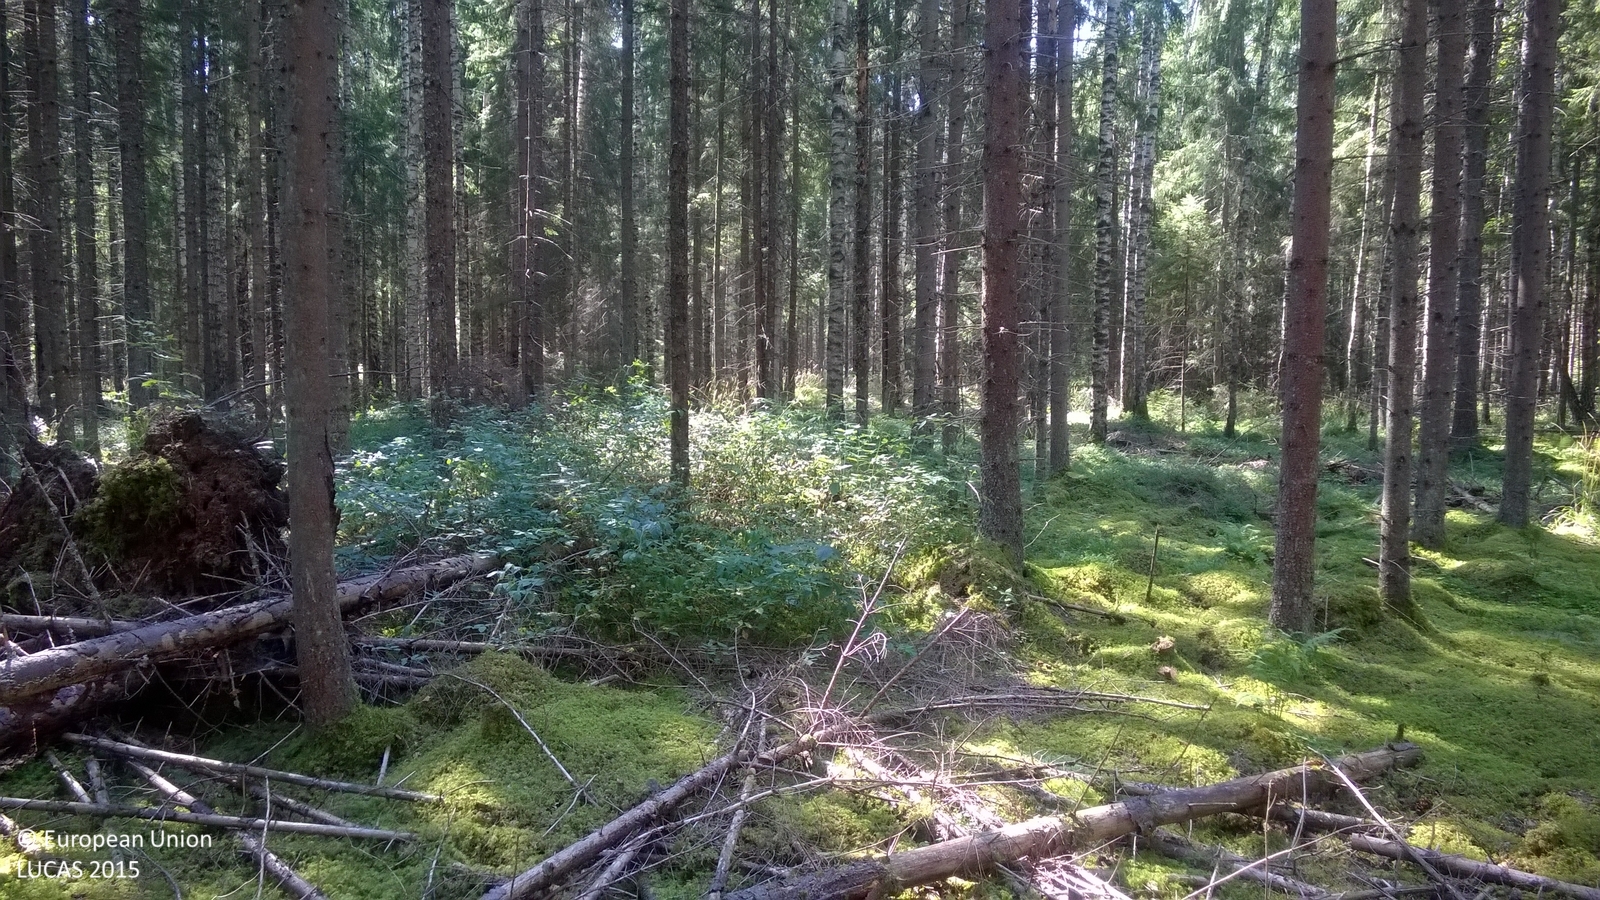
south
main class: Woodland
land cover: Spruce dominated mixed woodland
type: hemiboreal forest and nemoral coniferous forest and mixed broadleaved-coniferous forest
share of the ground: > 75 %
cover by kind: coniferous forest trees 60 %, broadleaved forest trees 25 %, lichens and mosses 10 %
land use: Forestry
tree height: > 5 m
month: August
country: LV
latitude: 57.5919
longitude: 26.0728
